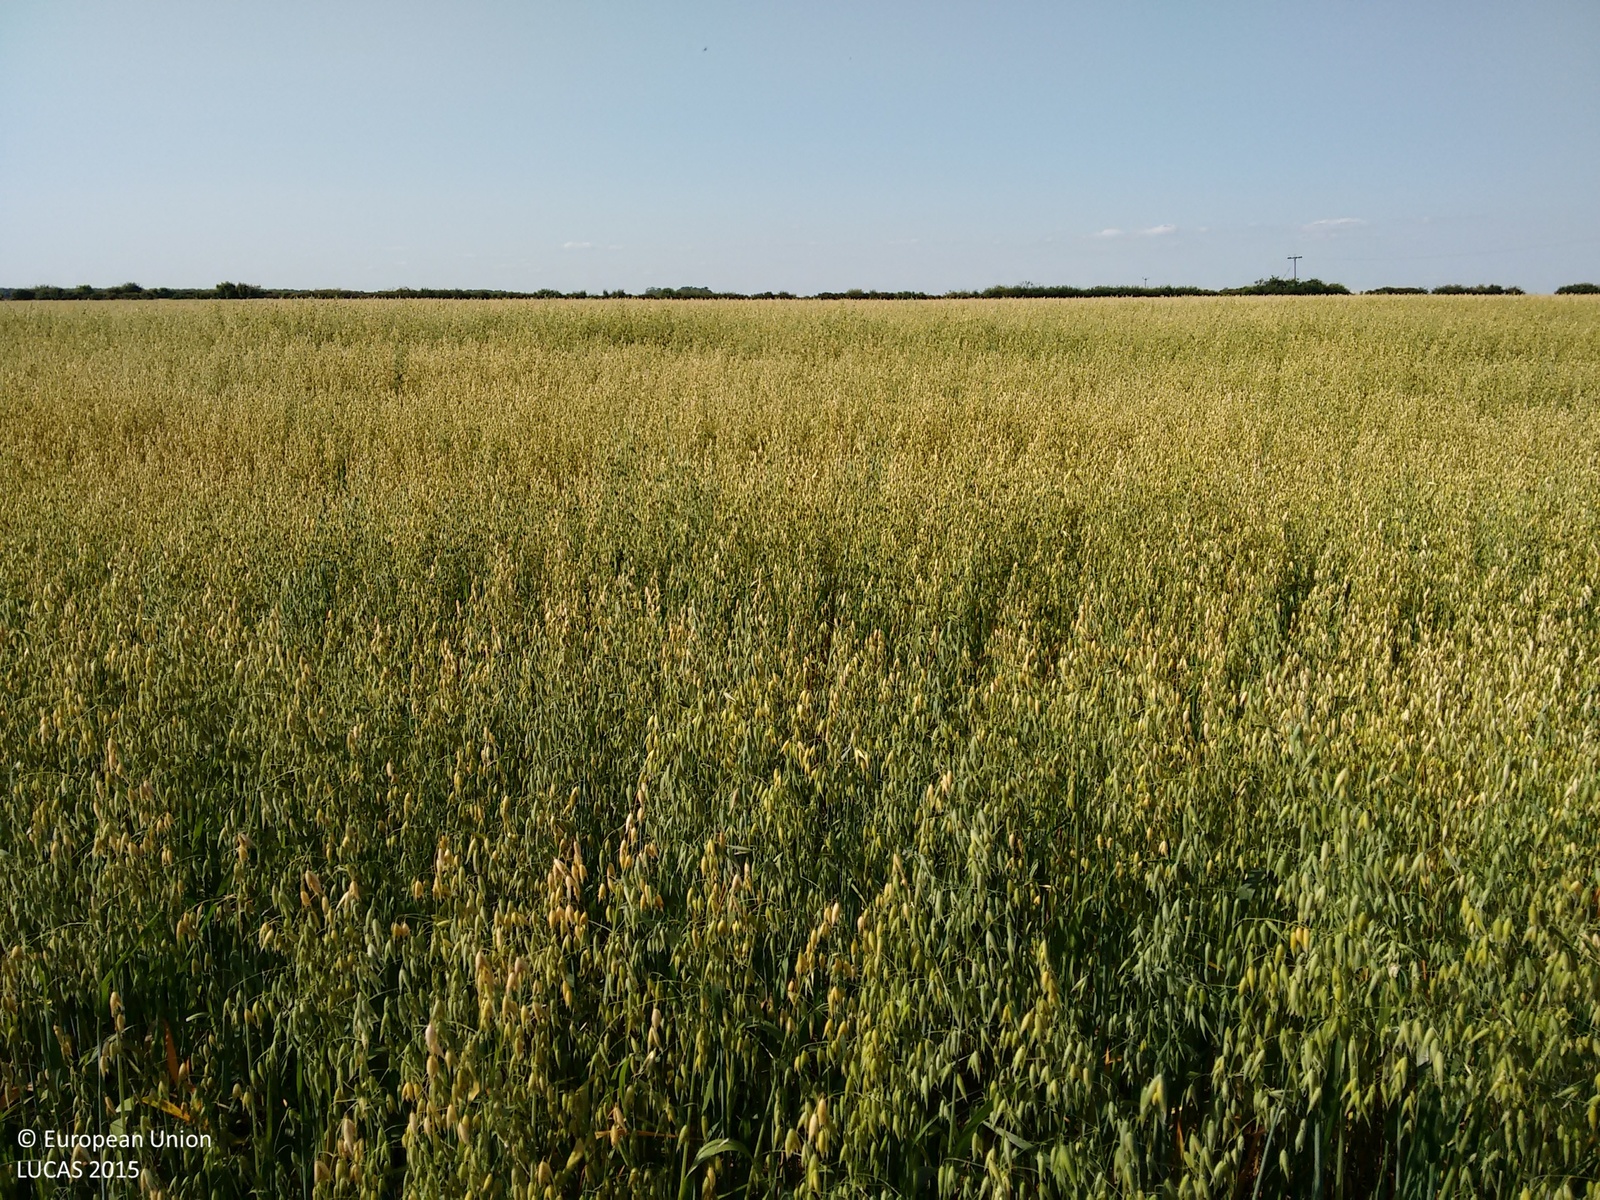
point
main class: Cropland
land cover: Oats
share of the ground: > 75 %
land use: Agriculture (excluding fallow land and kitchen gardens)
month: July
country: GB
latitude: 52.7056
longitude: -0.5315
